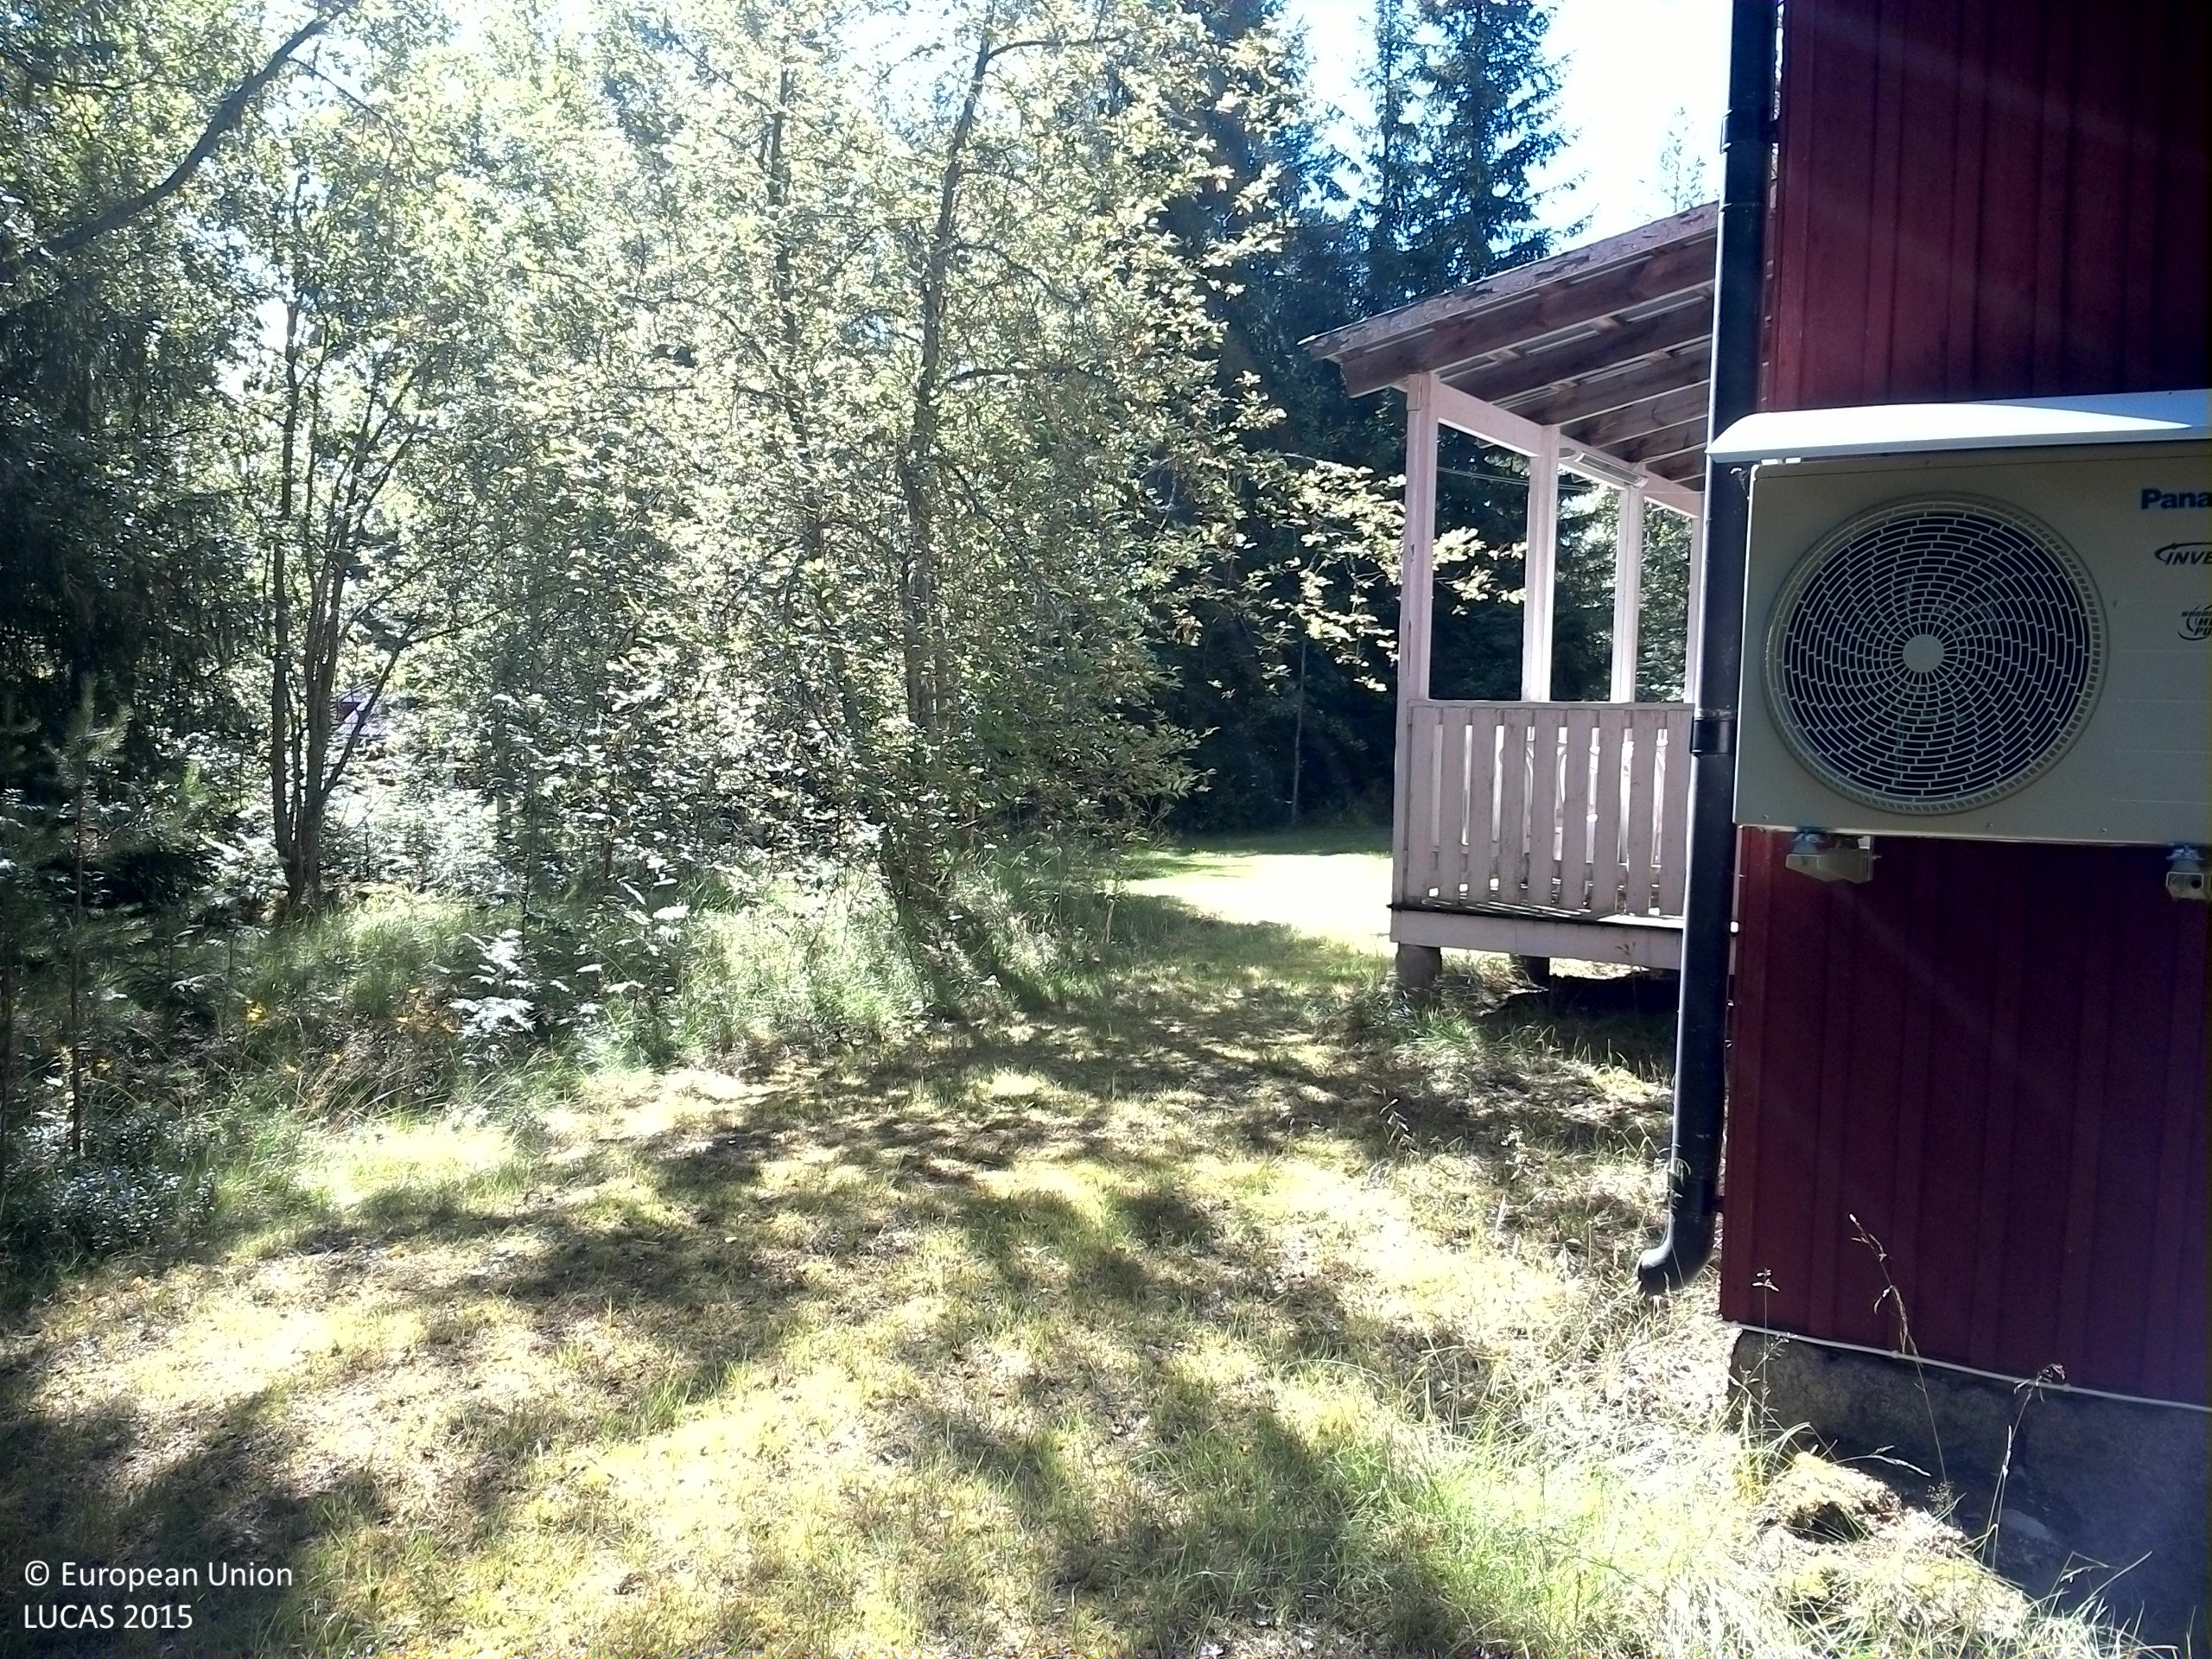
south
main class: Grassland
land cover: Grassland without tree/shrub cover
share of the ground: > 75 %
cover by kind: herbaceous plants 75 %, lichens and mosses 25 %
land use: Residential
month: August
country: SE
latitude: 63.7977
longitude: 16.4070
